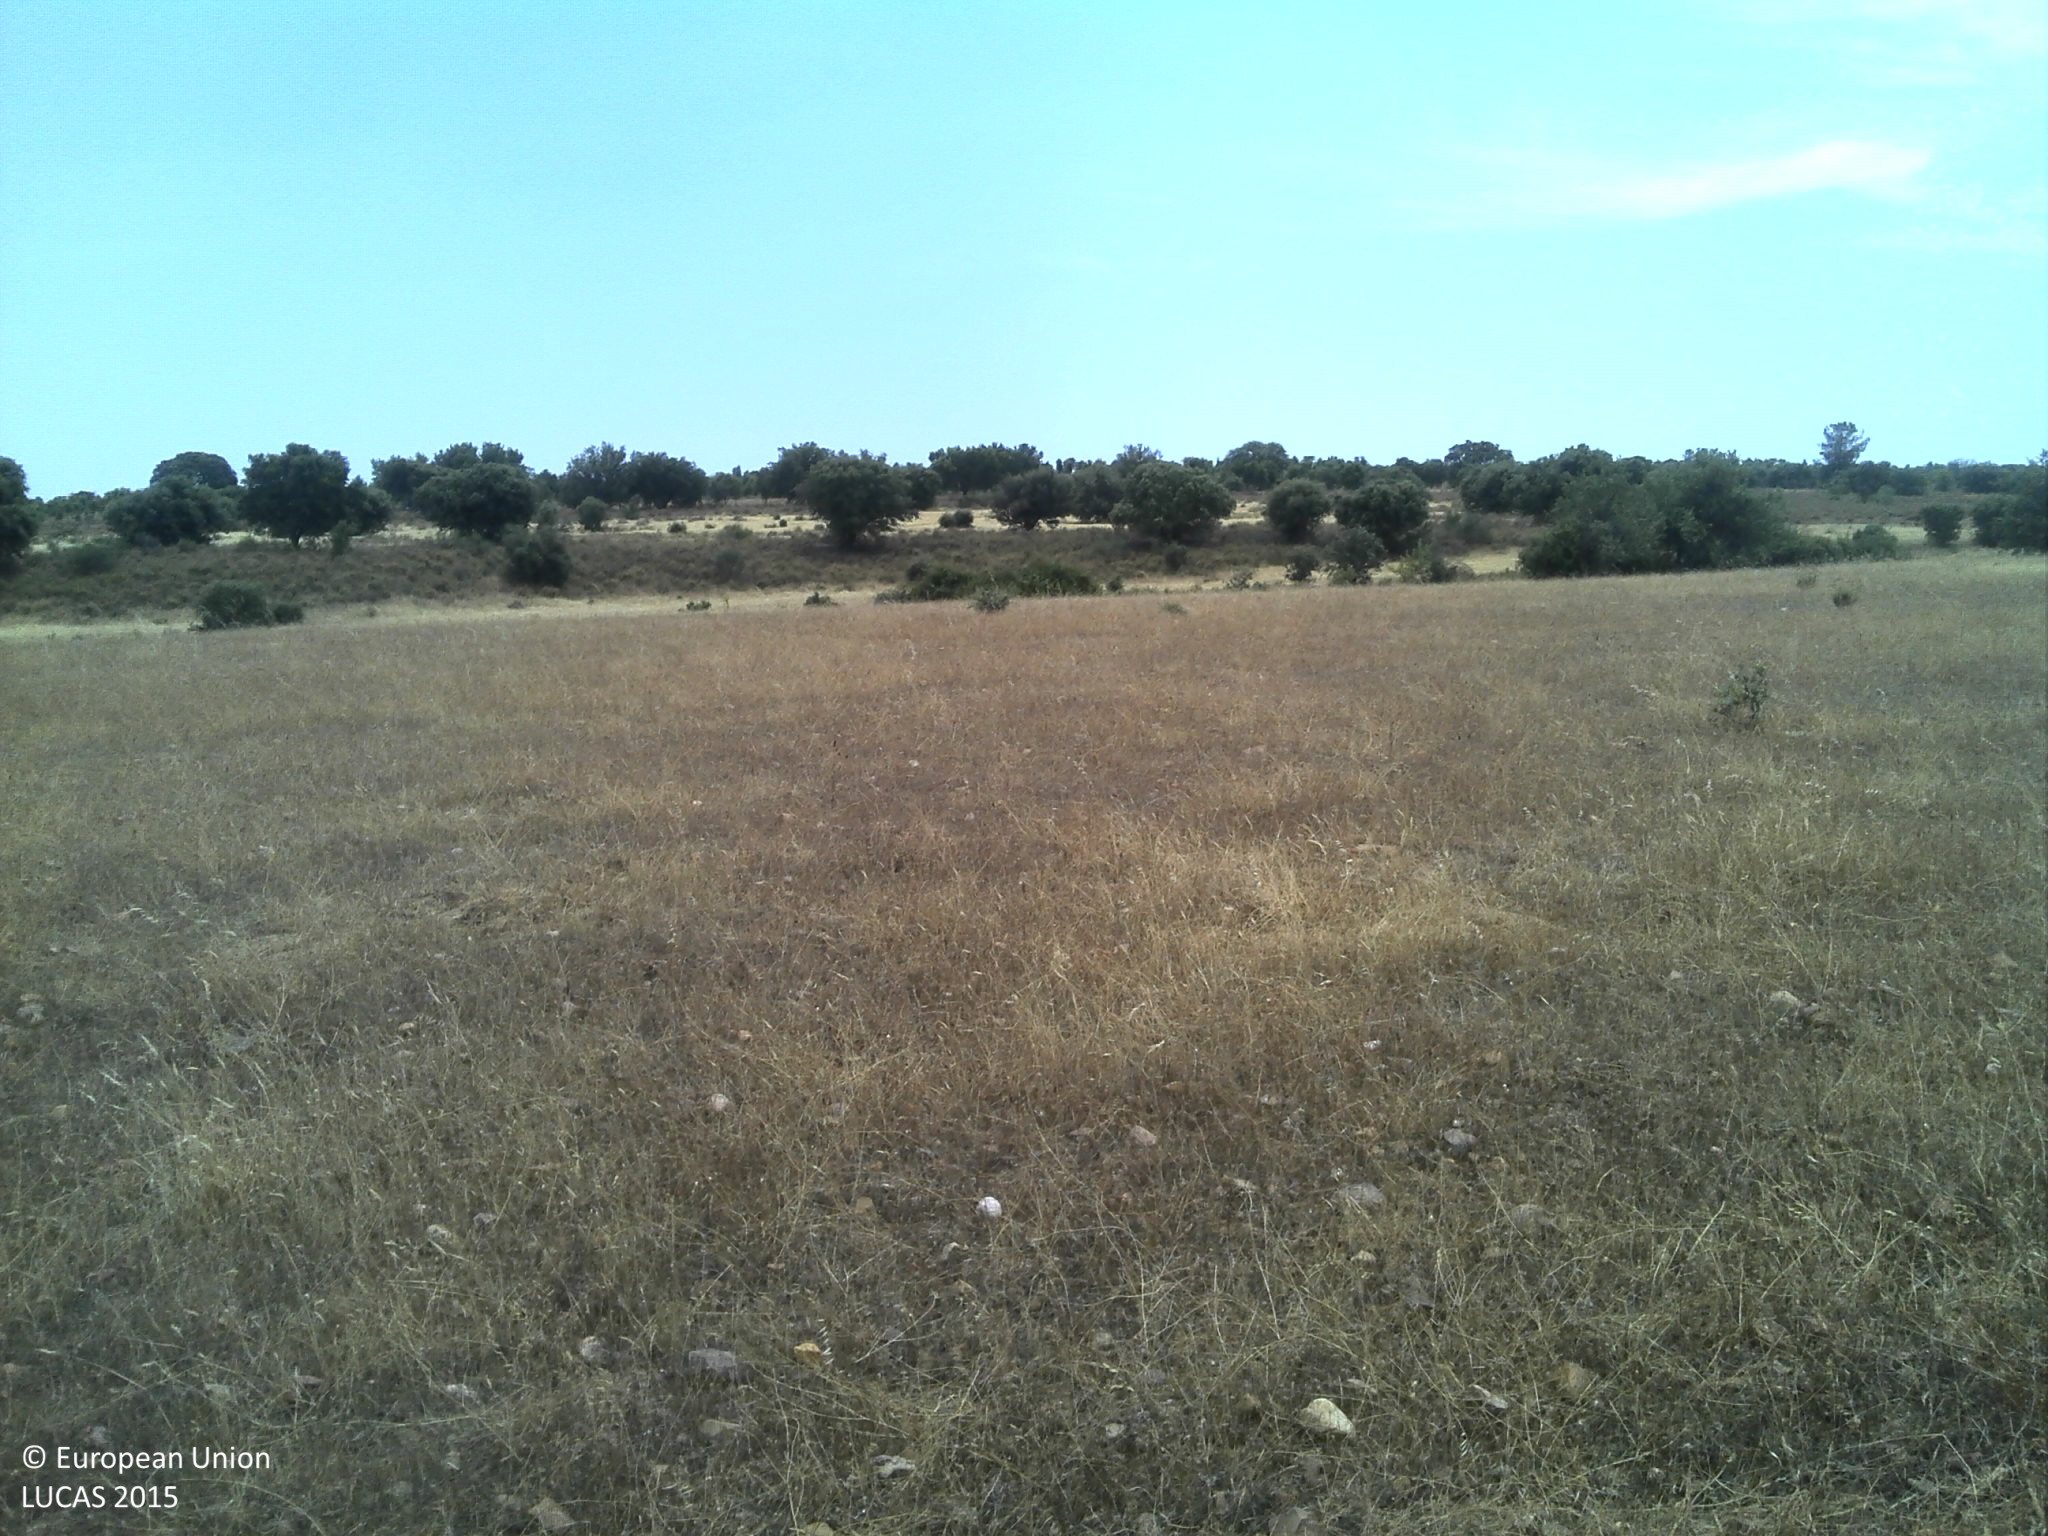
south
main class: Grassland
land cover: Grassland without tree/shrub cover
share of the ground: 25 - 50 %
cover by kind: unconsolidated bare surface 65 %, herbaceous plants 35 %
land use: Agriculture (excluding fallow land and kitchen gardens)
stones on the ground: 10 - 25 %
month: June
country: PT
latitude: 39.9550
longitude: -6.9804
